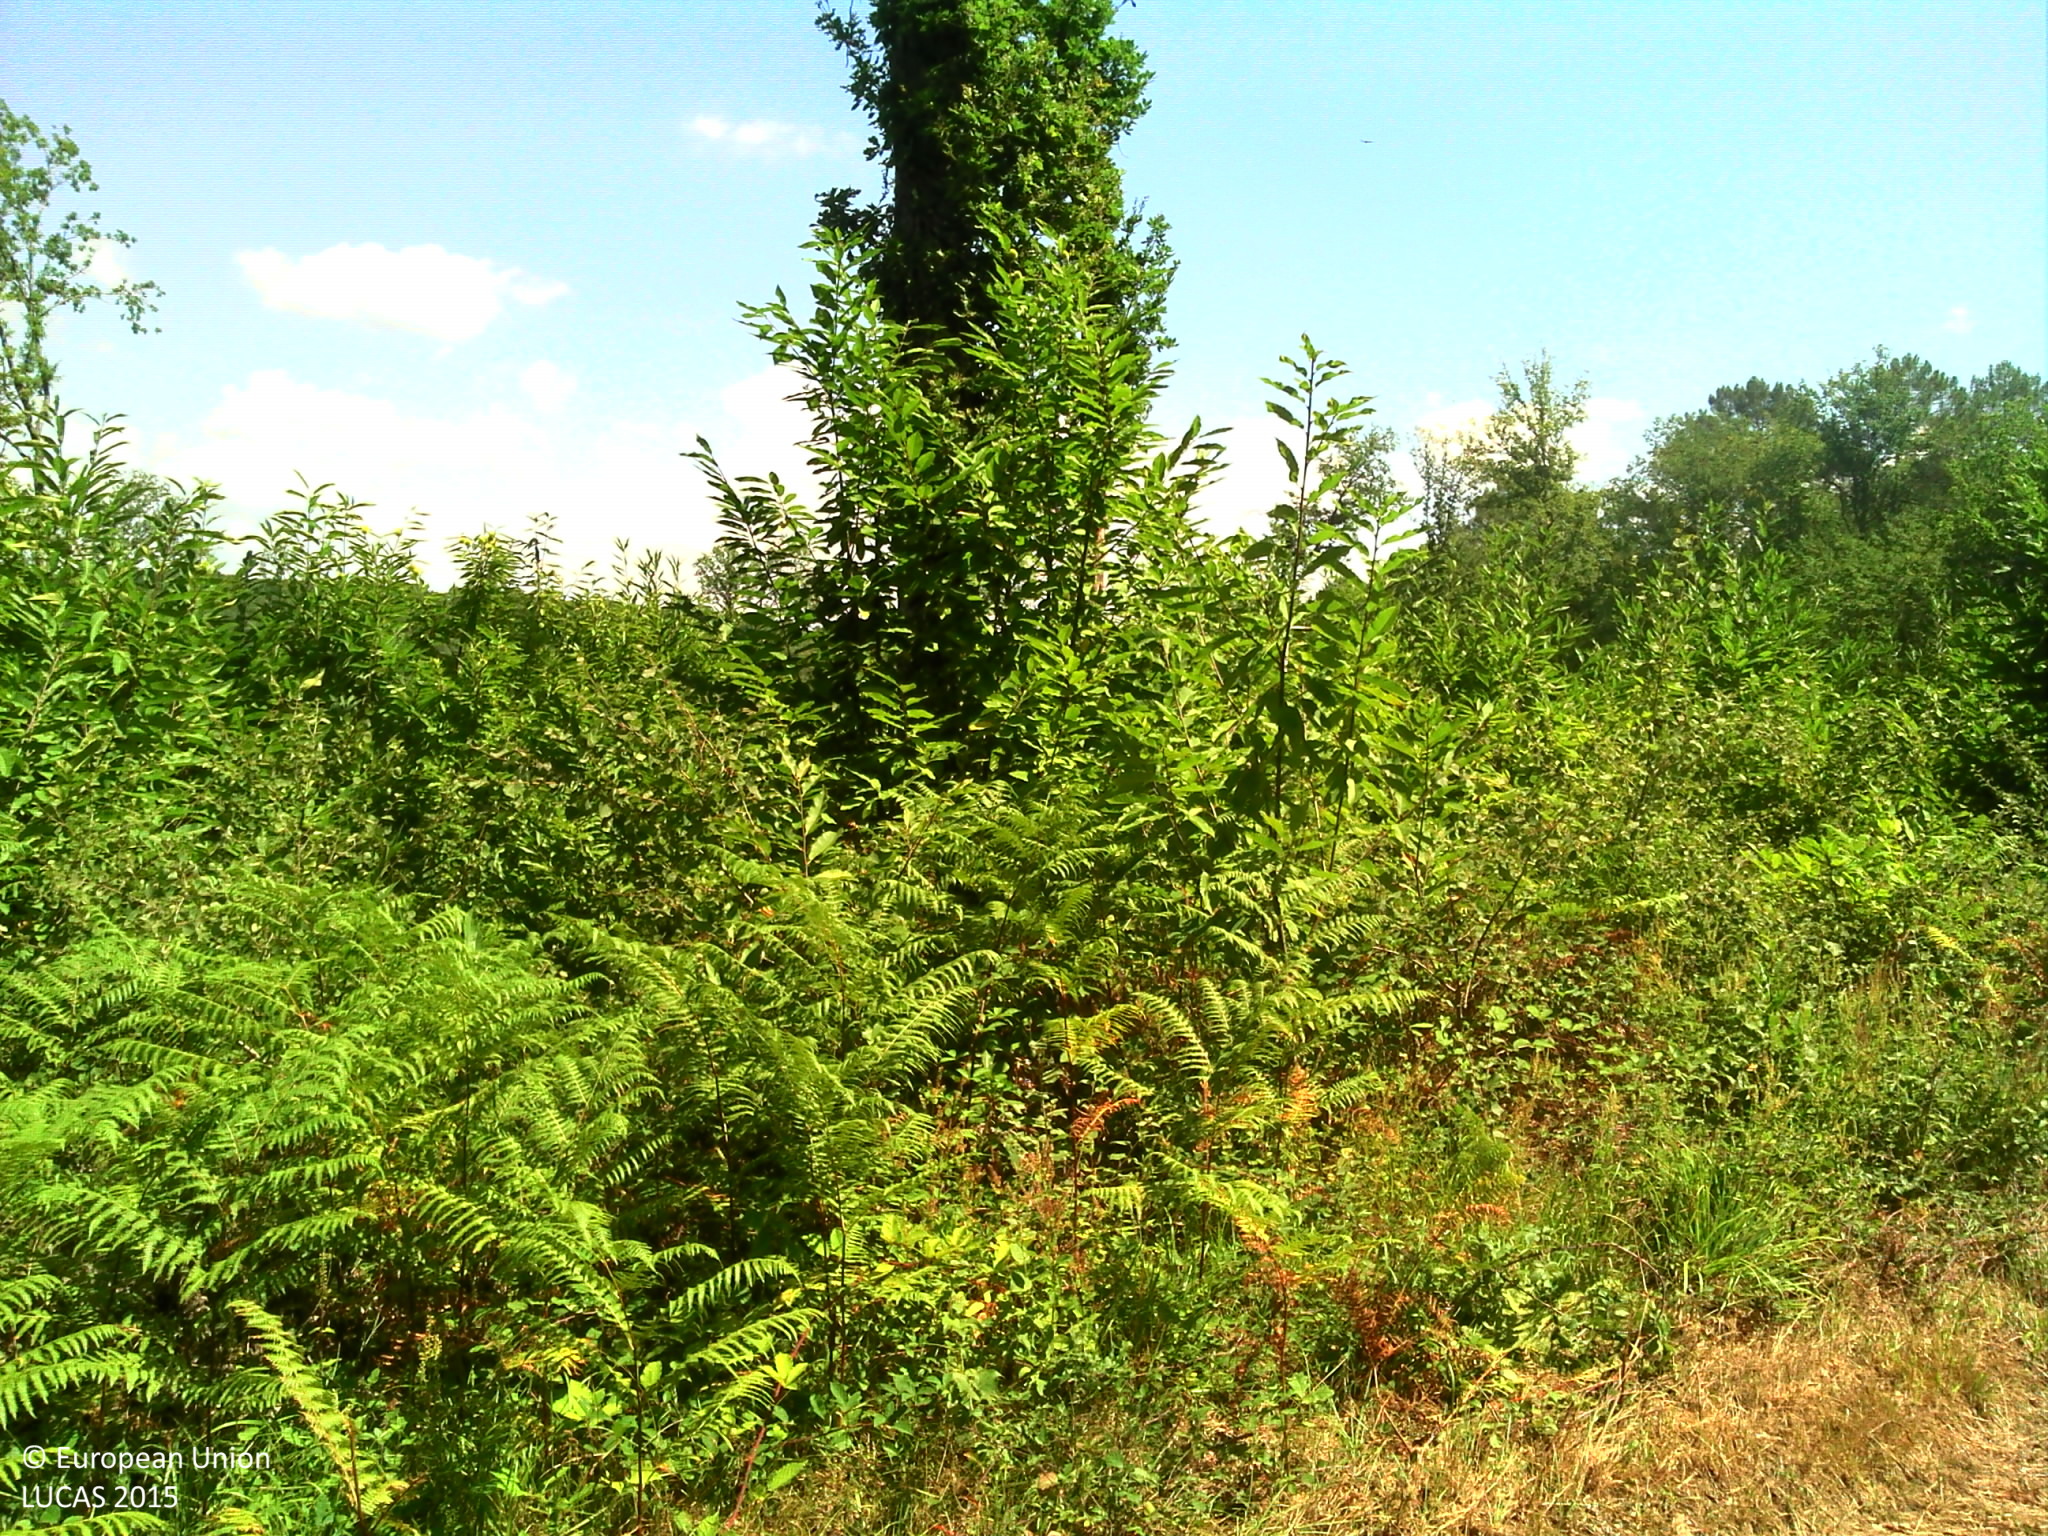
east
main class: Woodland
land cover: Pine dominated mixed woodland
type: coniferous forest of the mediterranean region
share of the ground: 25 - 50 %
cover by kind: herbaceous plants 40 %, broadleaved forest trees 30 %, shrubs 20 %, coniferous forest trees 10 %
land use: Forestry
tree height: < 5 m
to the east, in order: Pine dominated mixed woodland; Spontaneously vegetated surfaces; Tracks; Shrubland with sparse tree cover; Electric lines; Shrubland with sparse tree cover
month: August
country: FR
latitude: 45.2541
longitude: 0.6749
